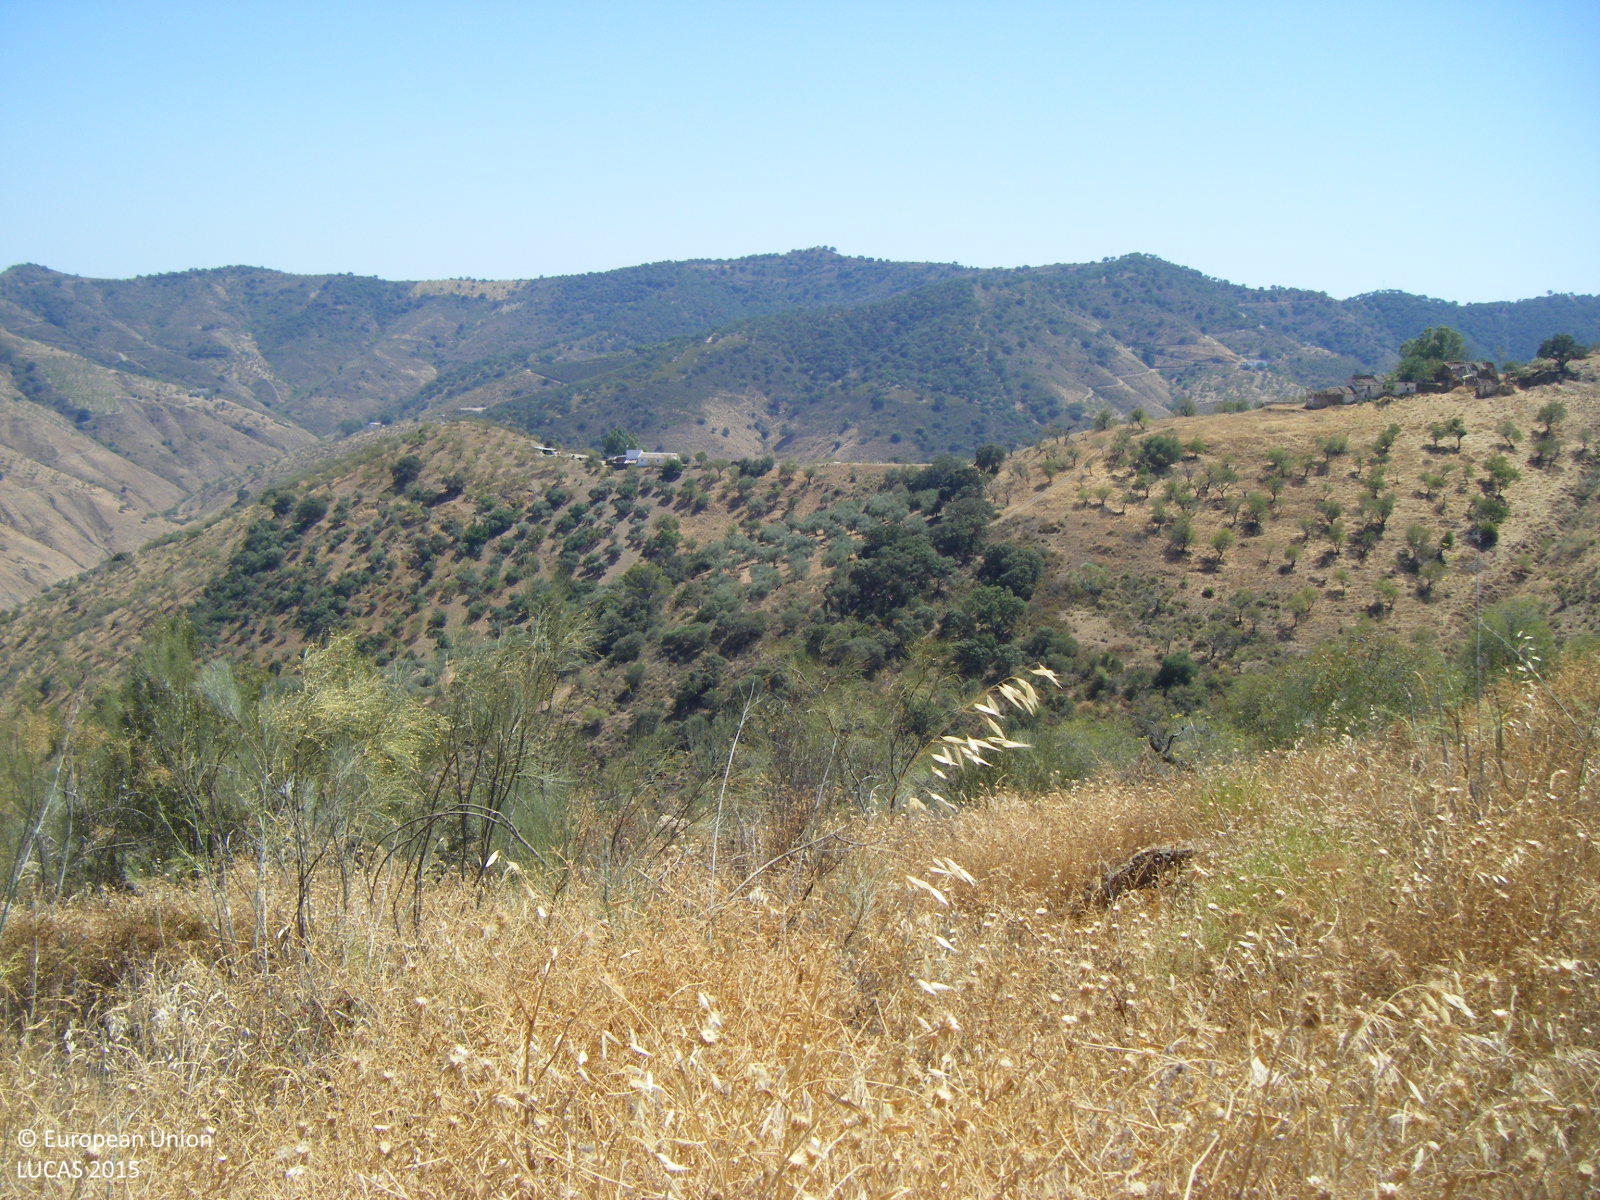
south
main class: Cropland
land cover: Nuts trees
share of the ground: 10 - 25 %
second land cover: Spontaneously vegetated surfaces
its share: > 75 %
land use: Abandoned areas
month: July
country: ES
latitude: 36.8395
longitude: -4.3330
